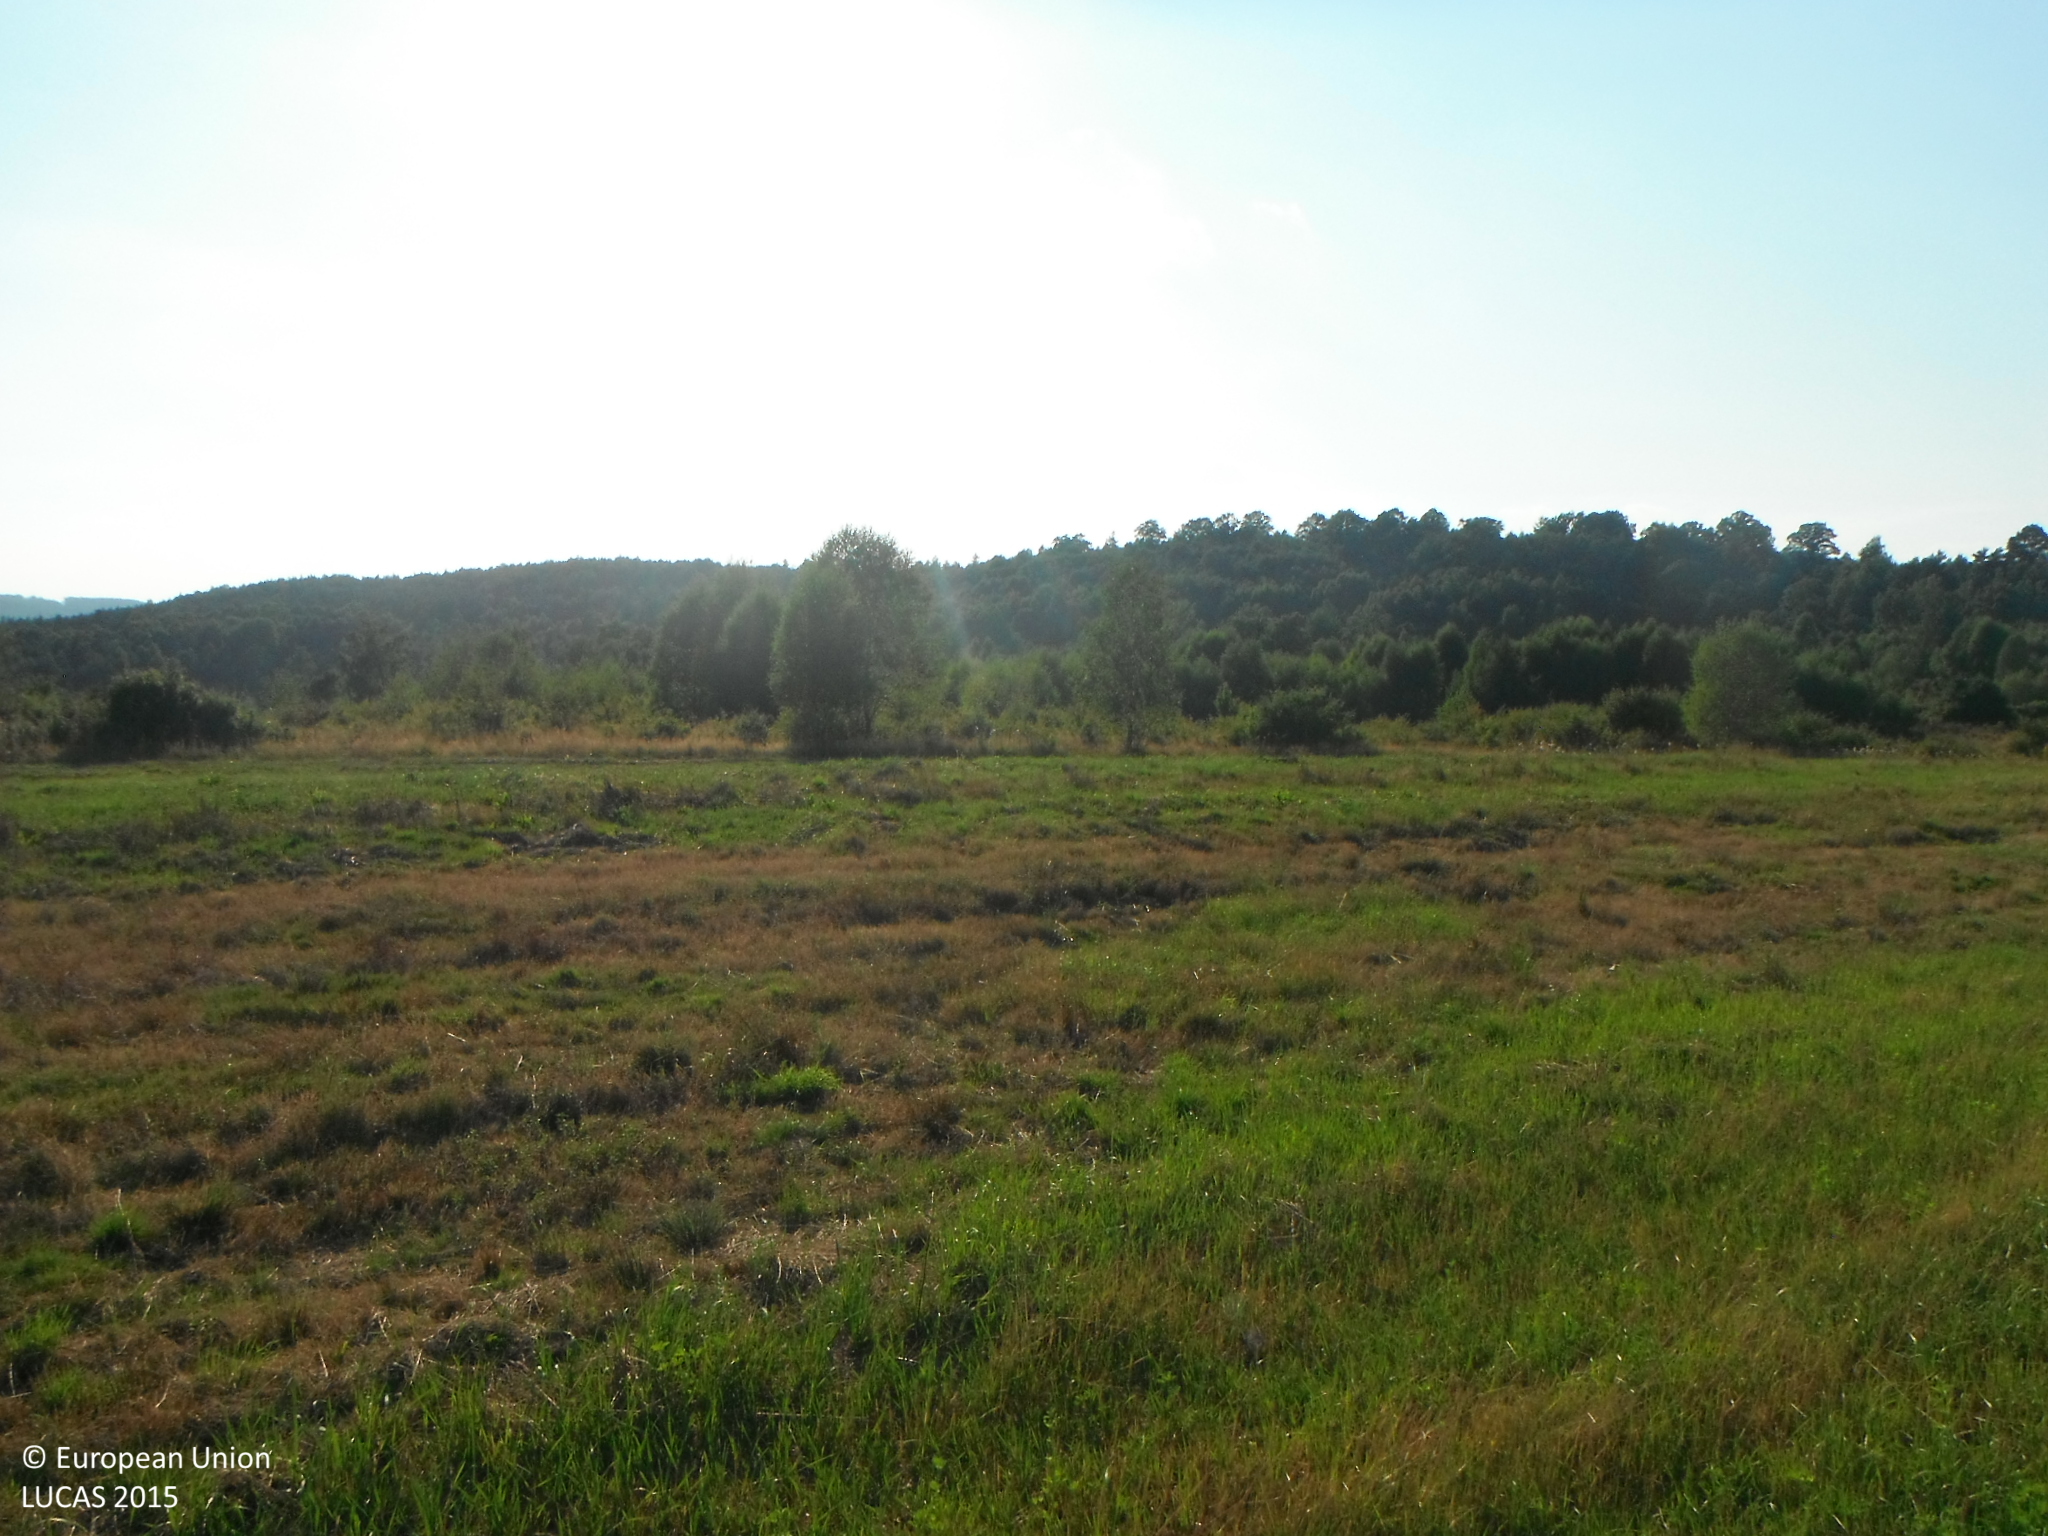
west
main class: Cropland
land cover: Other leguminous and mixtures for fodder
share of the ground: > 75 %
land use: Agriculture (excluding fallow land and kitchen gardens)
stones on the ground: < 10 %
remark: Harvested field
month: August
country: SK
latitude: 48.4246
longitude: 19.1160
